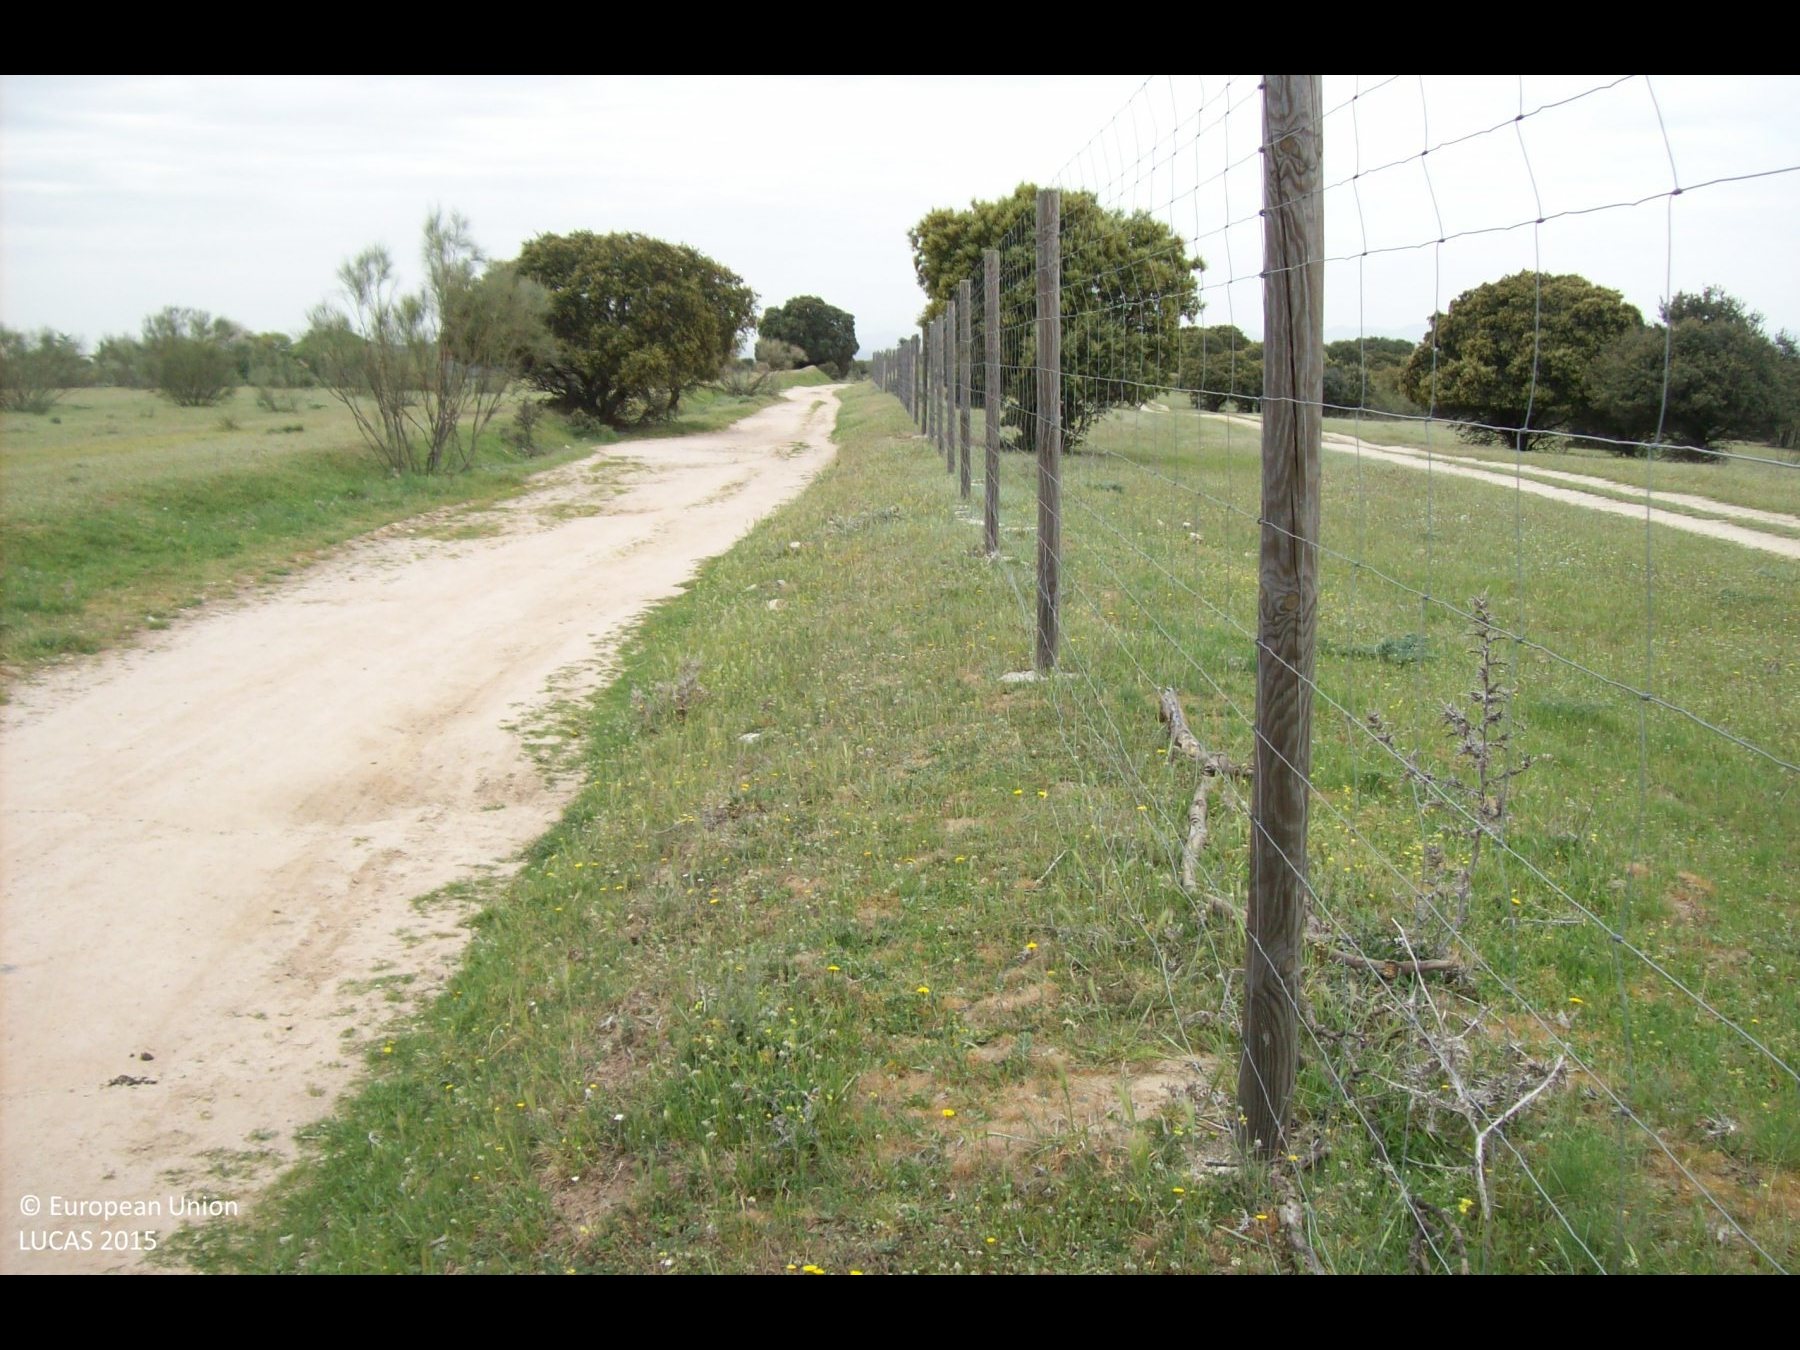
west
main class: Grassland
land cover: Grassland with sparse tree/shrub cover
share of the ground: > 75 %
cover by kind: herbaceous plants 75 %, broadleaved forest trees 5 %, shrubs 5 %
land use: Semi-natural and natural areas not in use
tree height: < 5 m
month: April
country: ES
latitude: 40.4429
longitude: -3.9174
